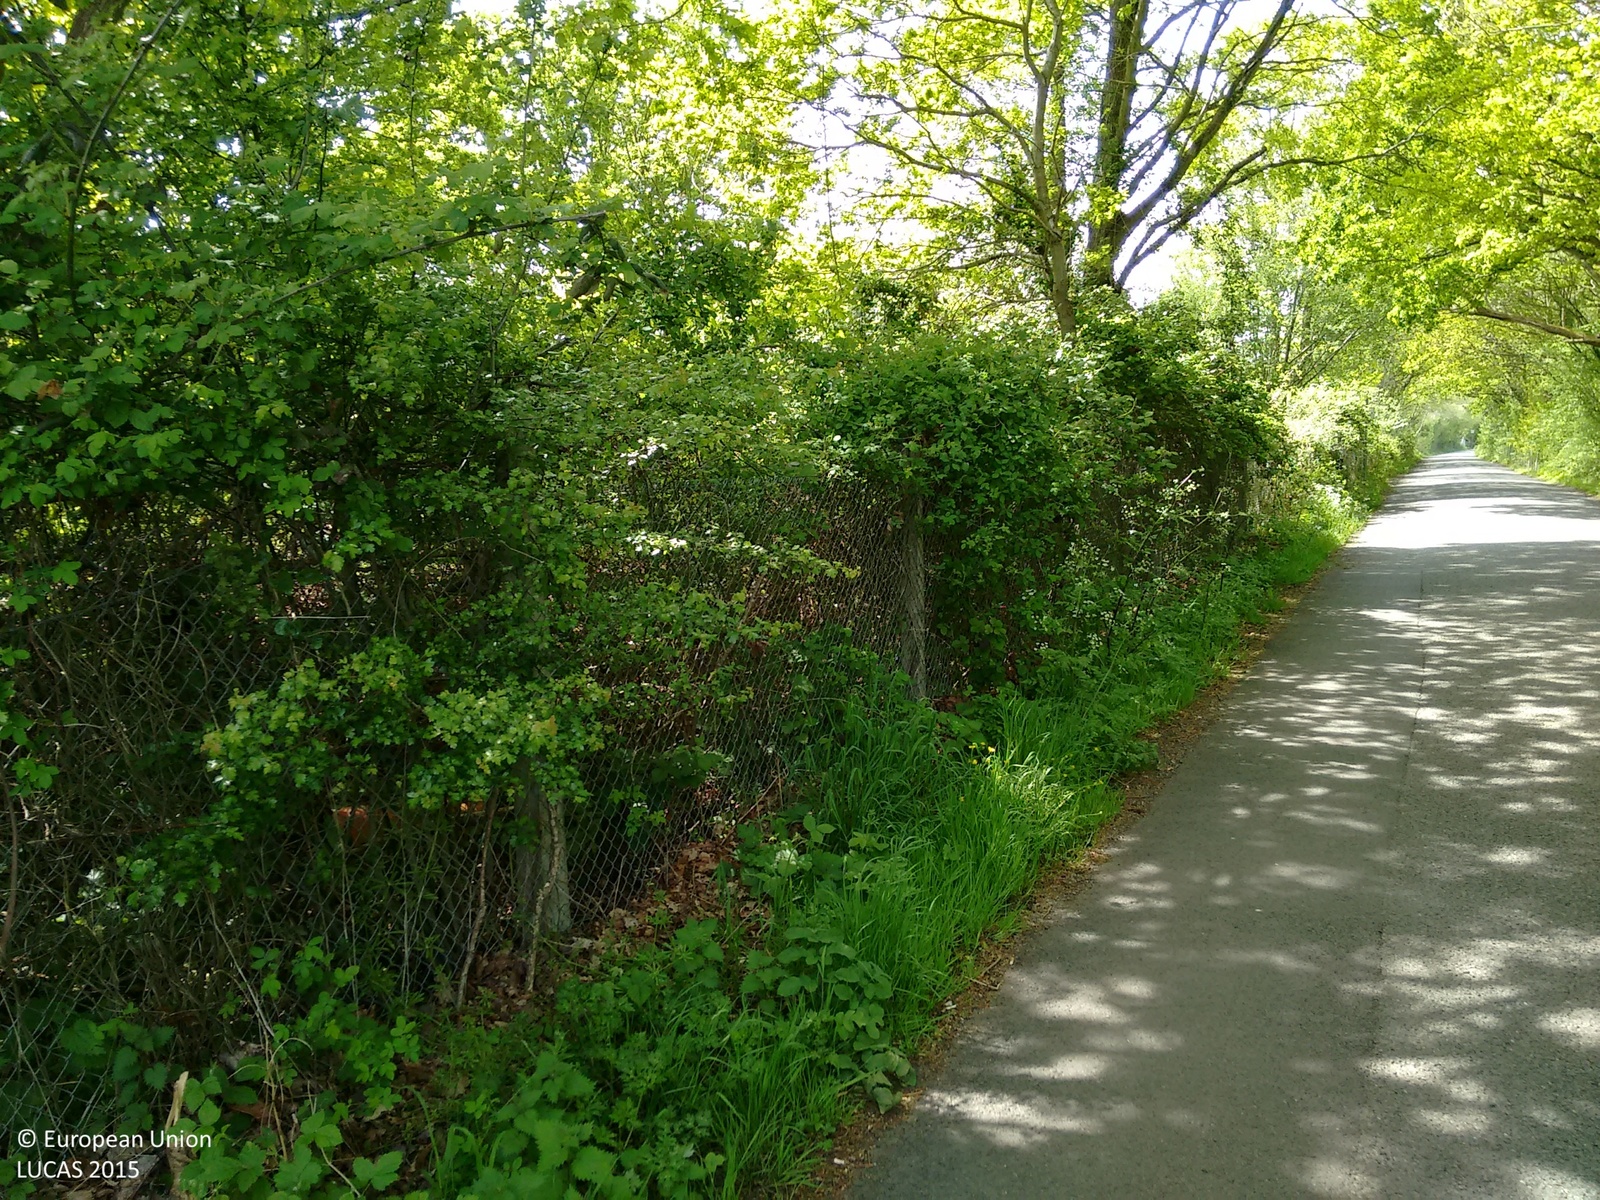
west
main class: Woodland
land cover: Broadleaved woodland
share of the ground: 25 - 50 %
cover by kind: broadleaved forest trees 45 %, herbaceous plants 45 %, shrubs 10 %
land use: Railway transport
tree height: > 5 m
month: May
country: GB
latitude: 51.1776
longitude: 0.4592
